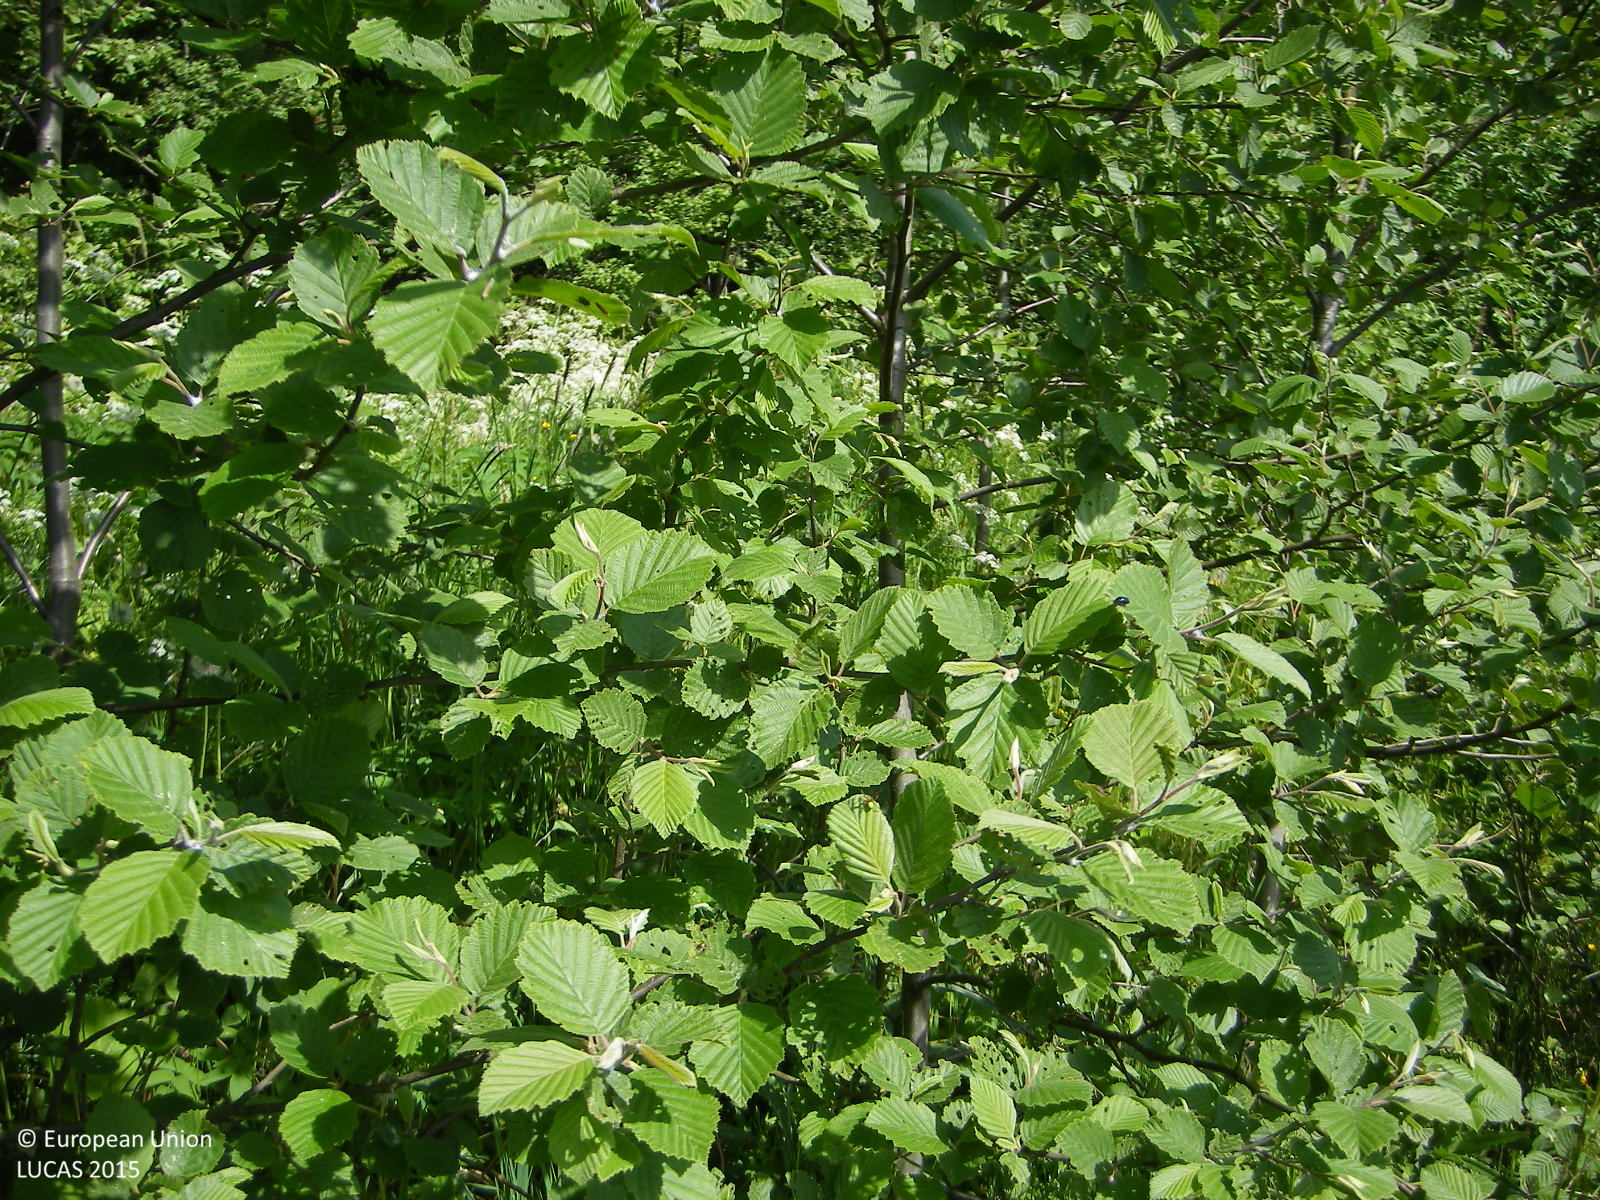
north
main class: Cropland
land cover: Other leguminous and mixtures for fodder
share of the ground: > 75 %
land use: Agriculture (excluding fallow land and kitchen gardens)
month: June
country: FI
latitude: 60.1427
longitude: 24.1292
